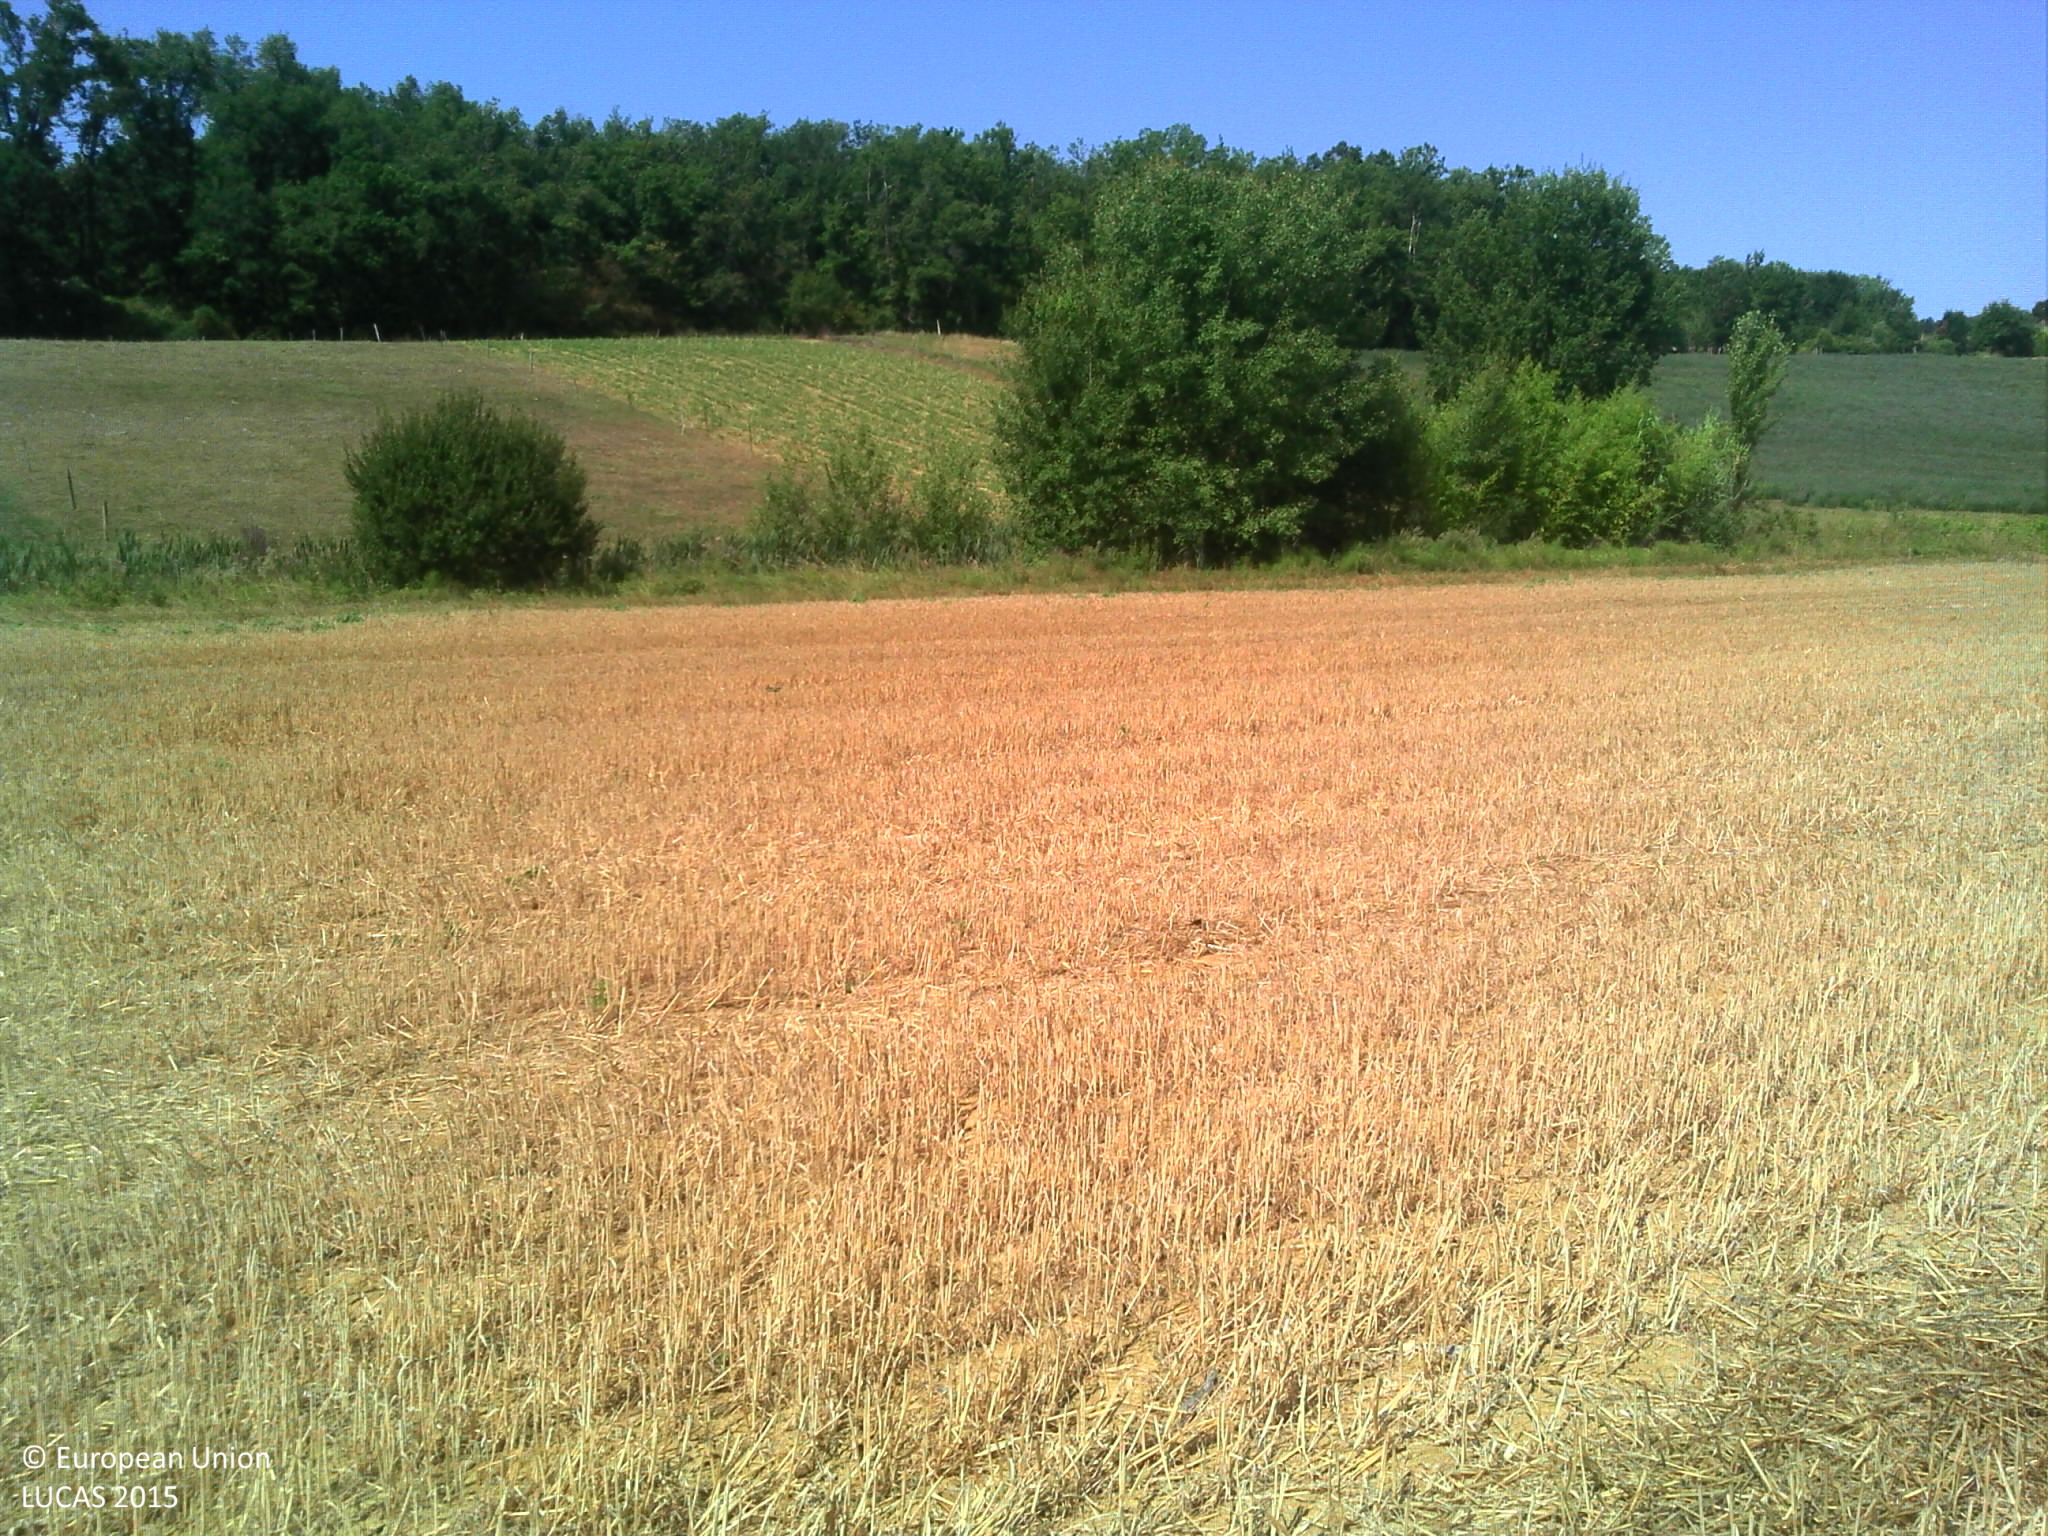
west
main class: Cropland
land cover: Common wheat
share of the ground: > 75 %
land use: Agriculture (excluding fallow land and kitchen gardens)
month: August
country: FR
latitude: 44.1960
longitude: 1.2273
